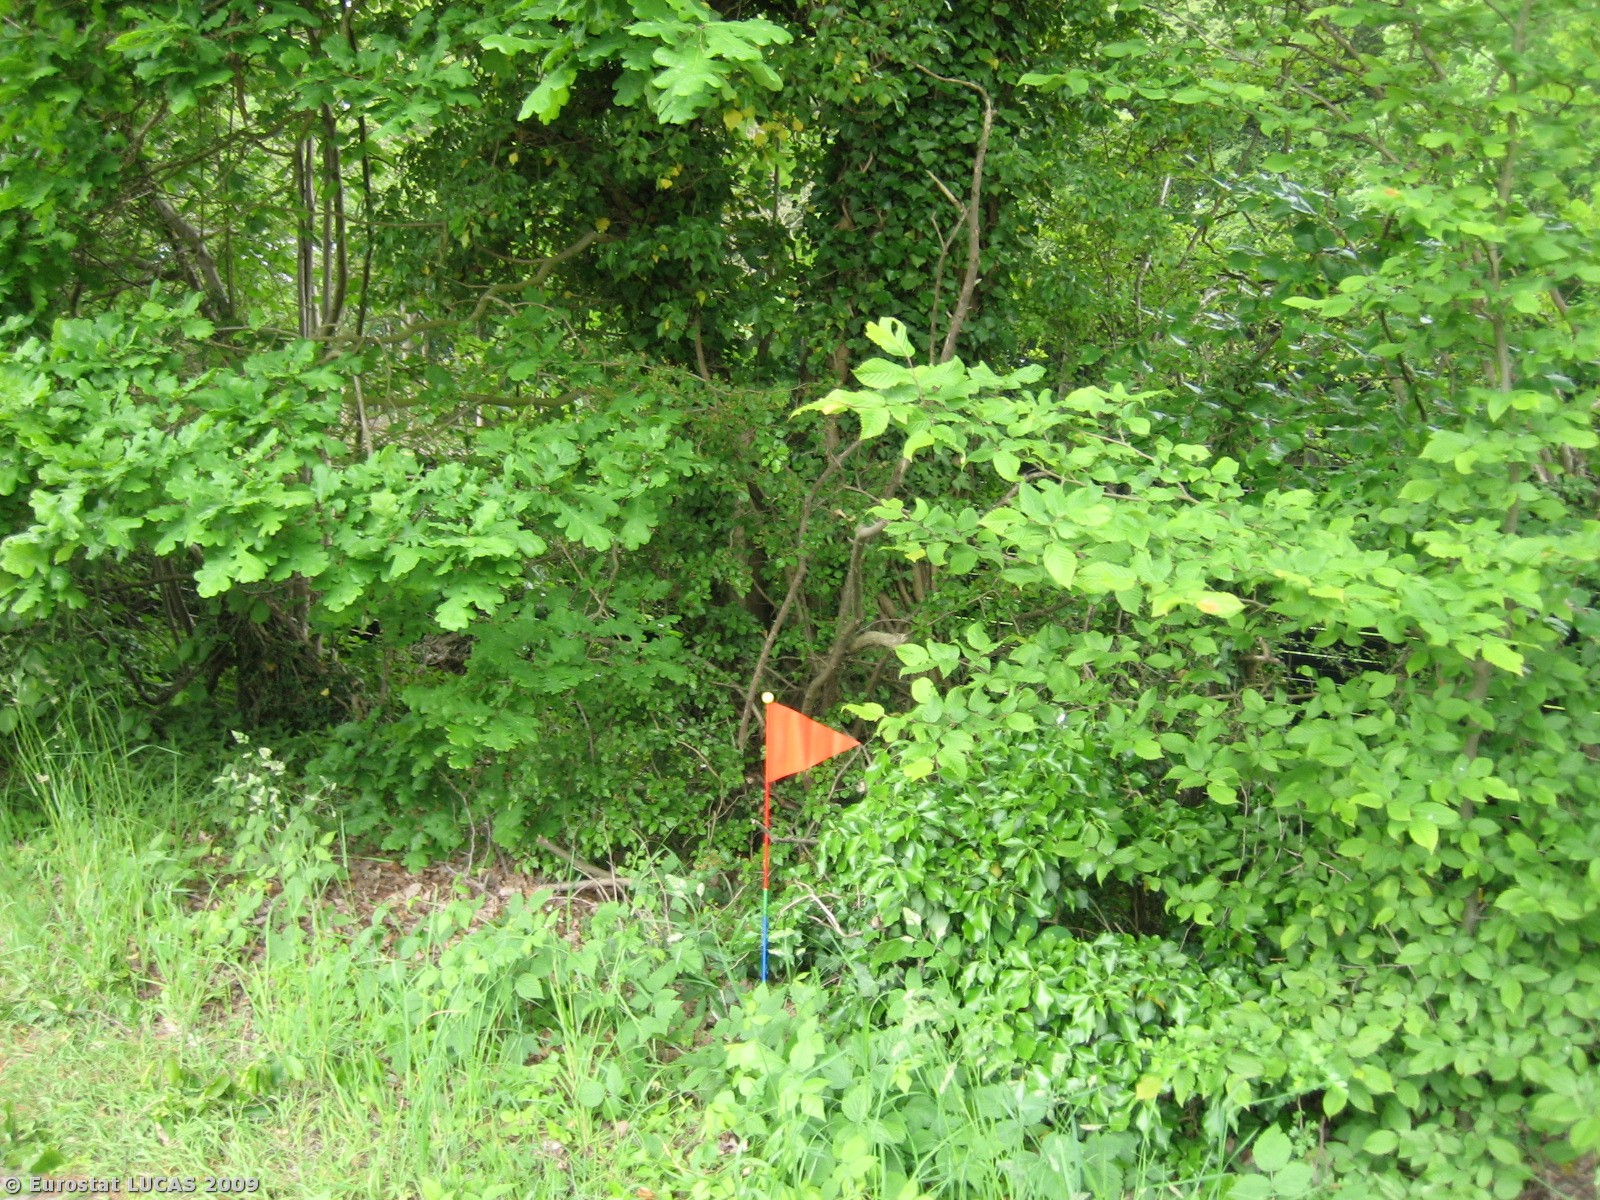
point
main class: Woodland
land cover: Broadleaved woodland
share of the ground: > 75 %
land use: Unused
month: June
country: DK
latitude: 56.2414
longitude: 10.2740
